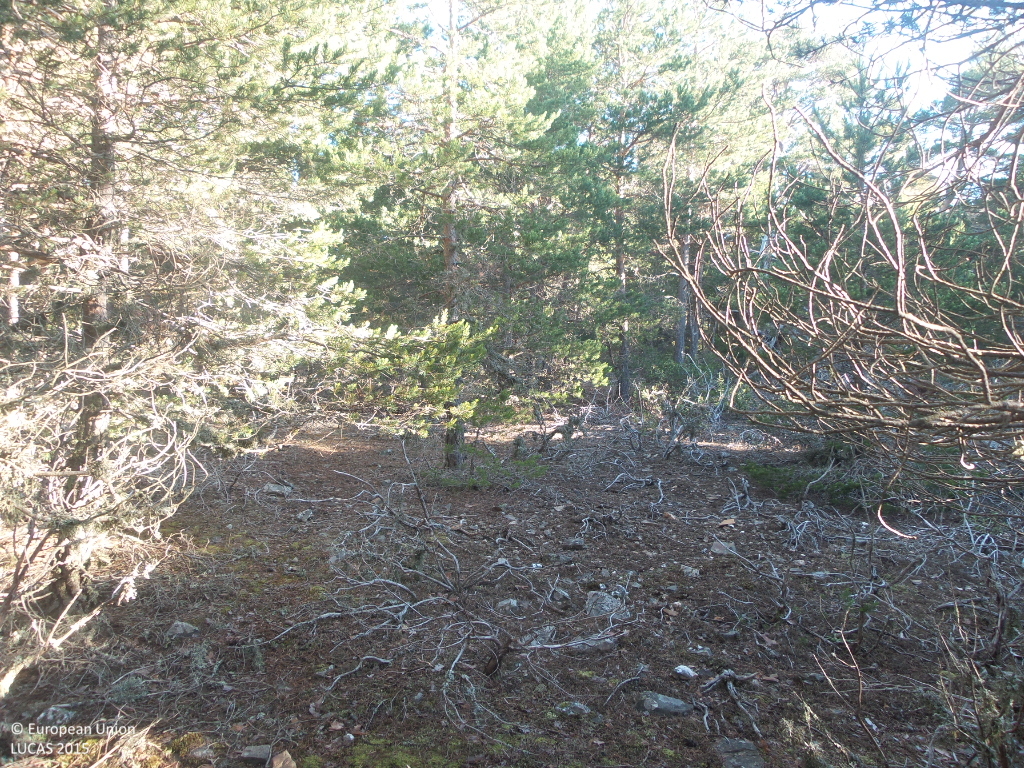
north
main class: Woodland
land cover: Pine dominated coniferous woodland
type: coniferous forest of the mediterranean region
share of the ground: > 75 %
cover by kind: coniferous forest trees 85 %, shrubs 5 %, lichens and mosses 5 %, unconsolidated bare surface 5 %
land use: Forestry
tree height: > 5 m
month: June
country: ES
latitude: 41.1965
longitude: -3.0960
